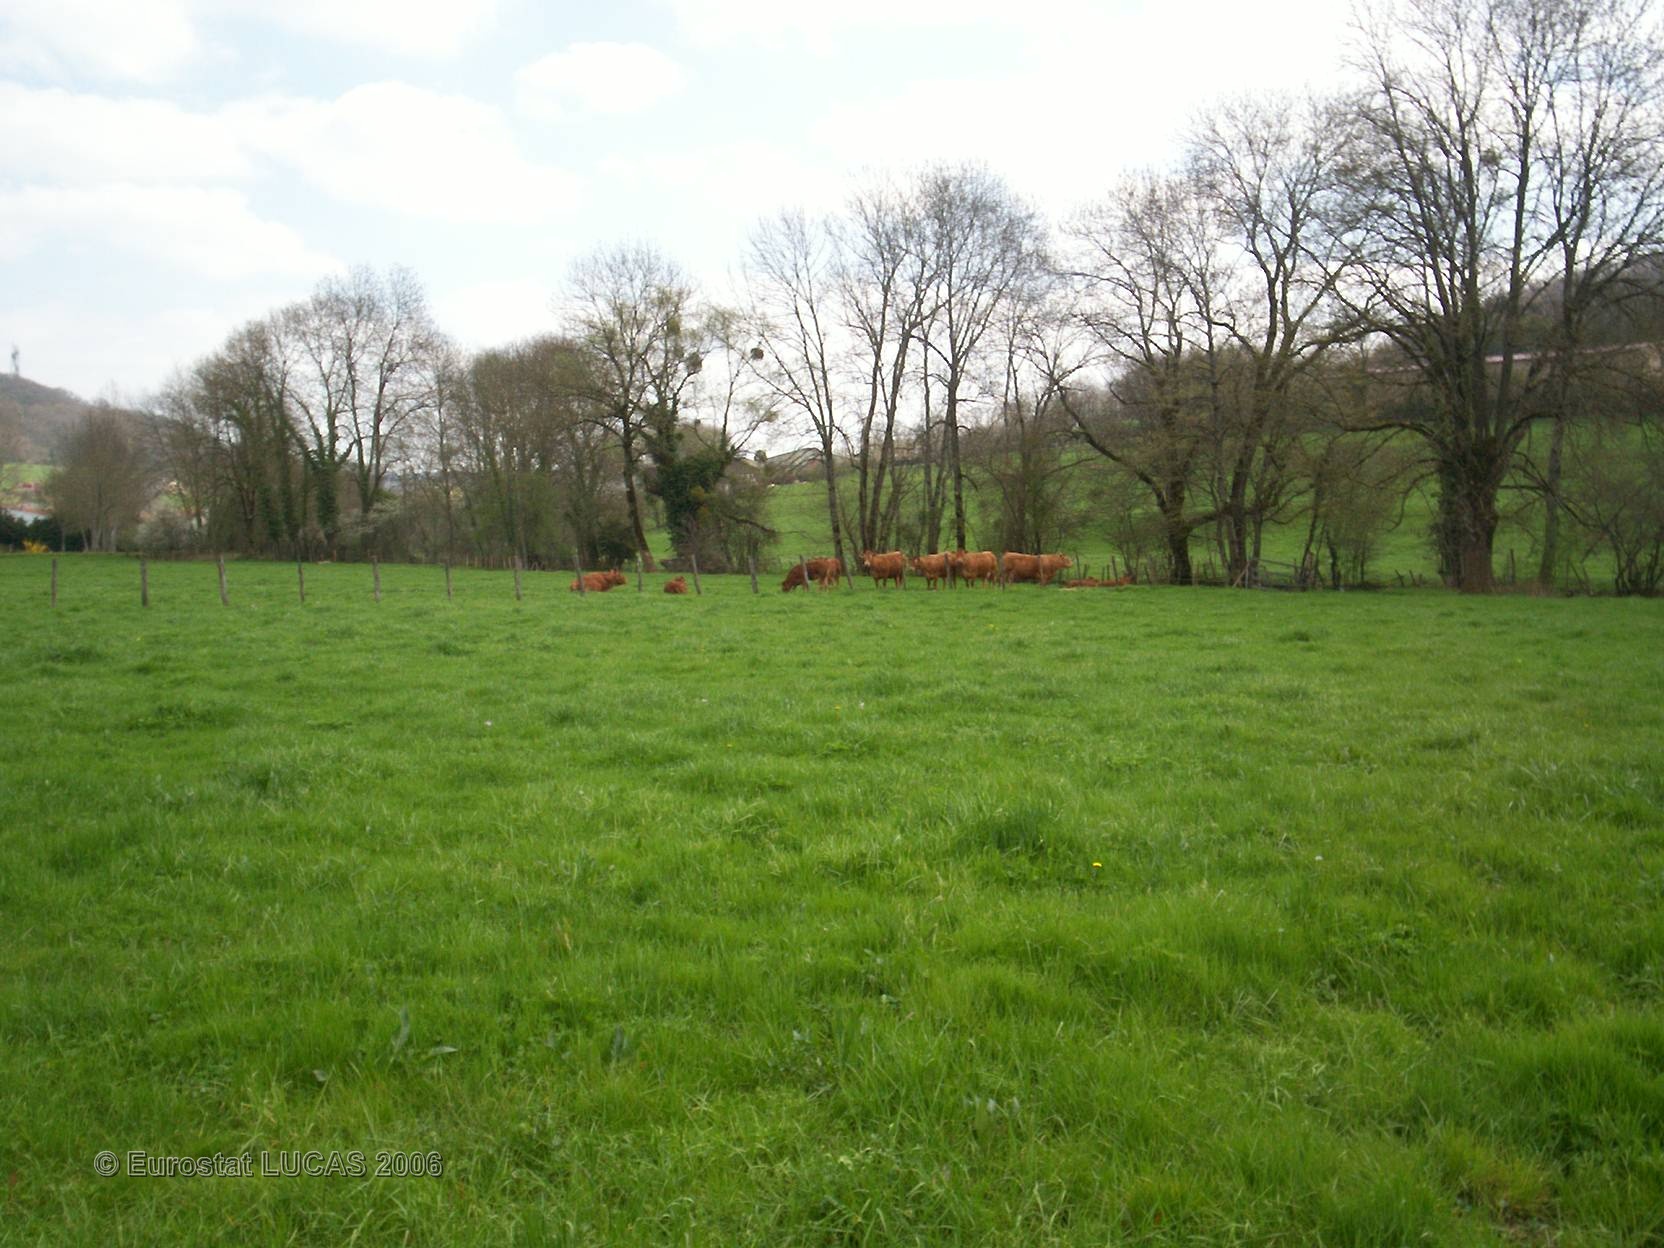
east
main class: Grassland
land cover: Grassland without tree/shrub cover
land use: Agriculture (excluding fallow land and kitchen gardens)
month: April
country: FR
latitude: 47.5484
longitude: 4.5646
